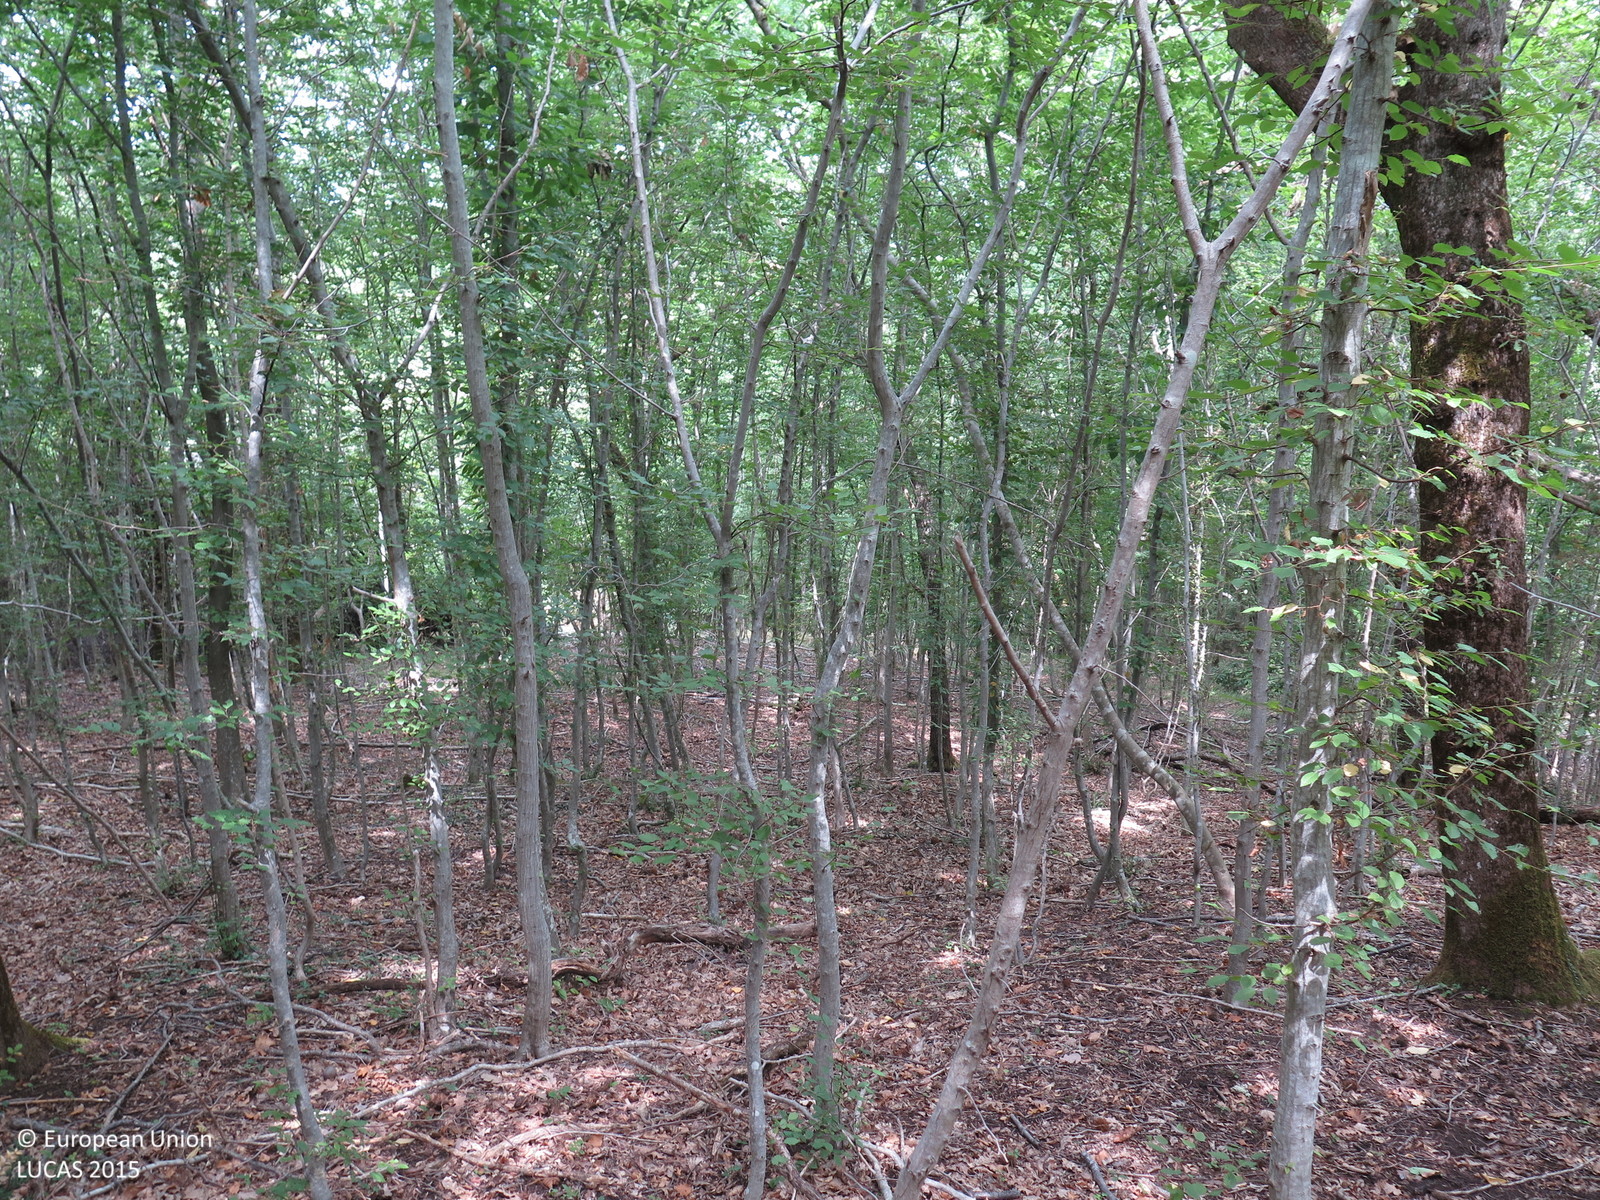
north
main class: Woodland
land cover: Broadleaved woodland
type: beech forest
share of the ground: > 75 %
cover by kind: broadleaved forest trees 100 %
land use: Forestry
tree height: > 5 m
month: August
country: HR
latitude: 45.1521
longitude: 14.5863
